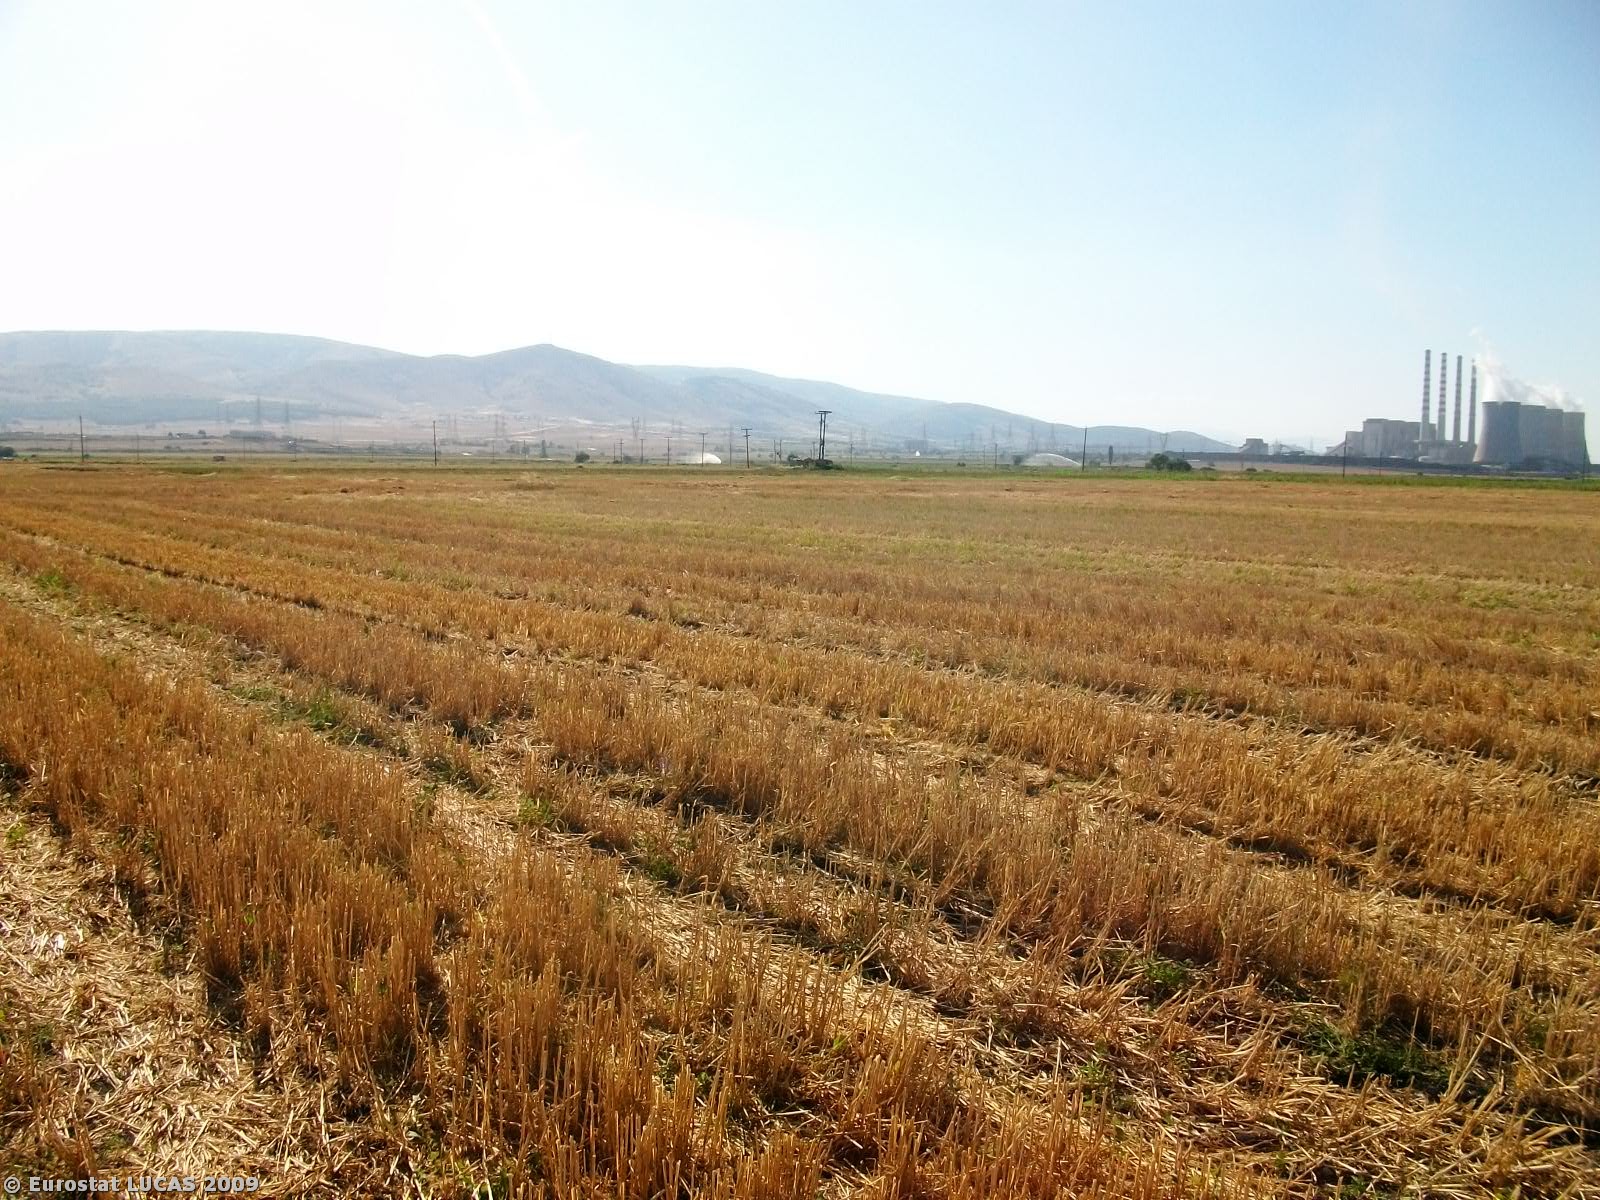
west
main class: Cropland
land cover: Durum wheat
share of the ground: < 10 %
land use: Agriculture (excluding fallow land and kitchen gardens)
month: July
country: GR
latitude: 40.3915
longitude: 21.8092
